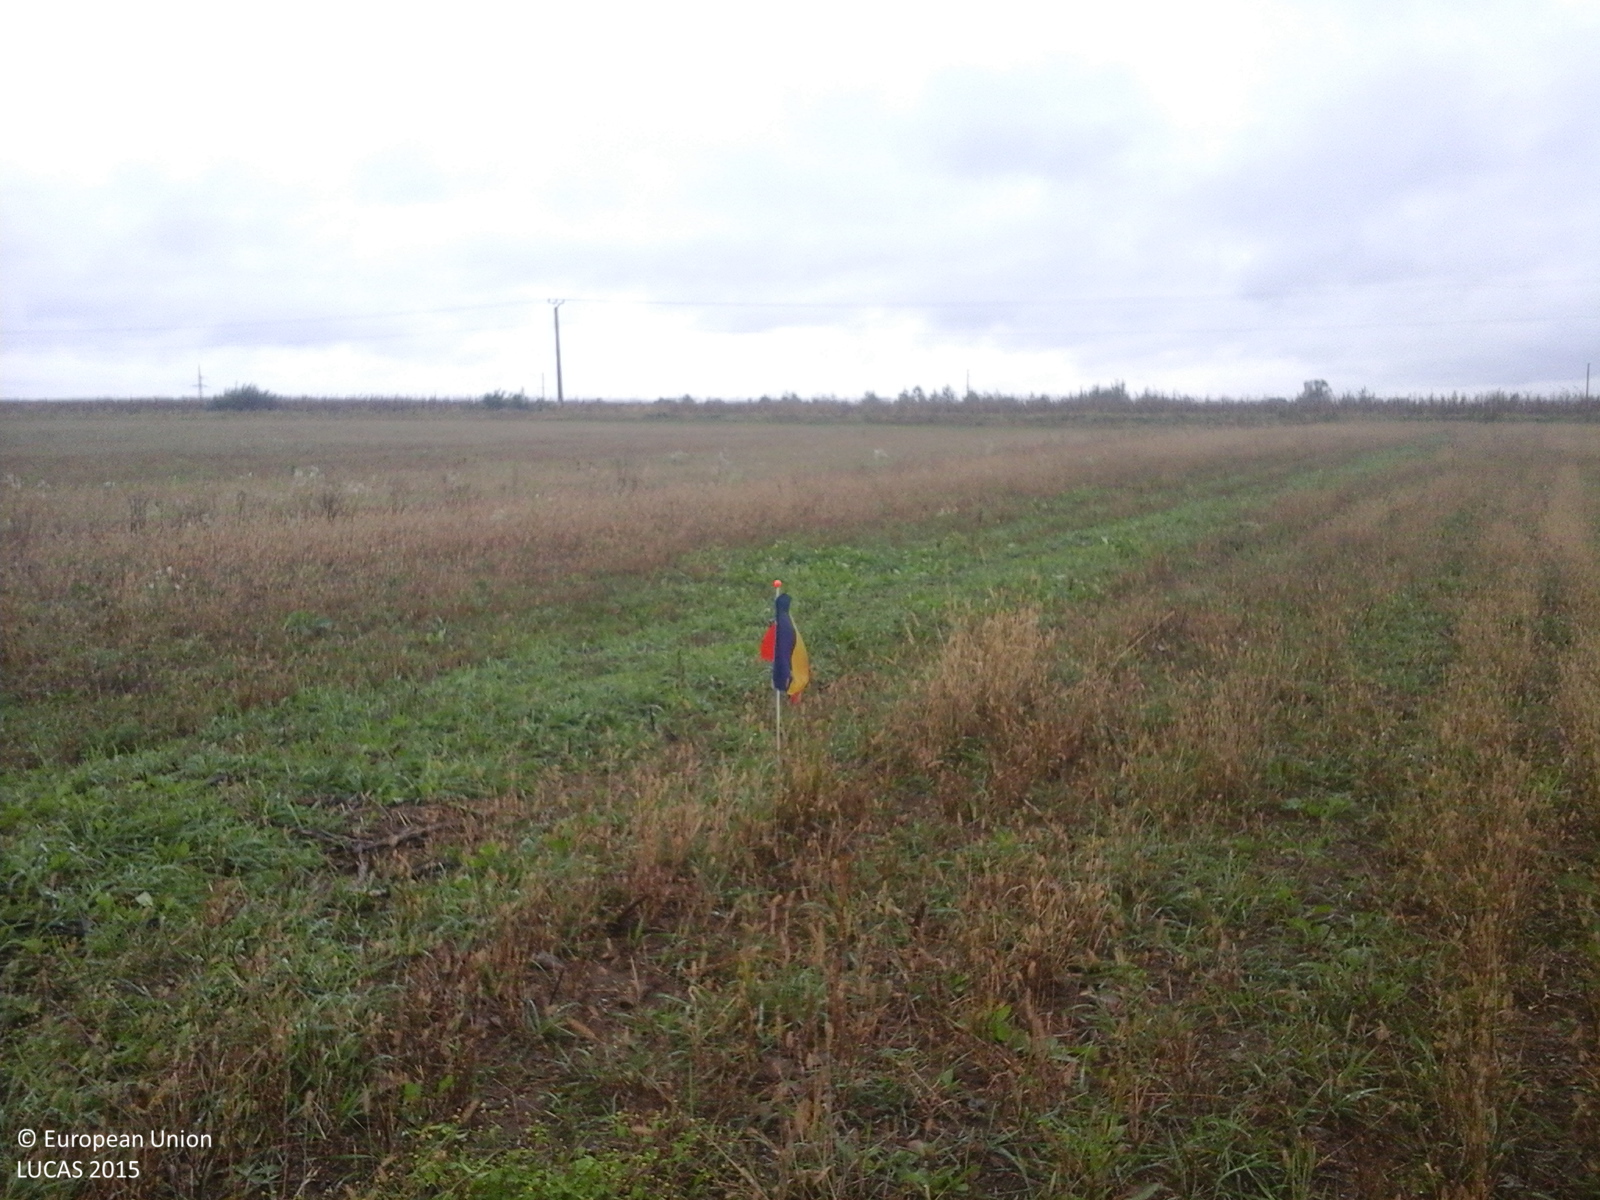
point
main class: Grassland
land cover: Grassland without tree/shrub cover
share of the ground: > 75 %
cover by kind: herbaceous plants 100 %
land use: Agriculture (excluding fallow land and kitchen gardens)
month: October
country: RO
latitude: 45.7811
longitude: 24.6047
